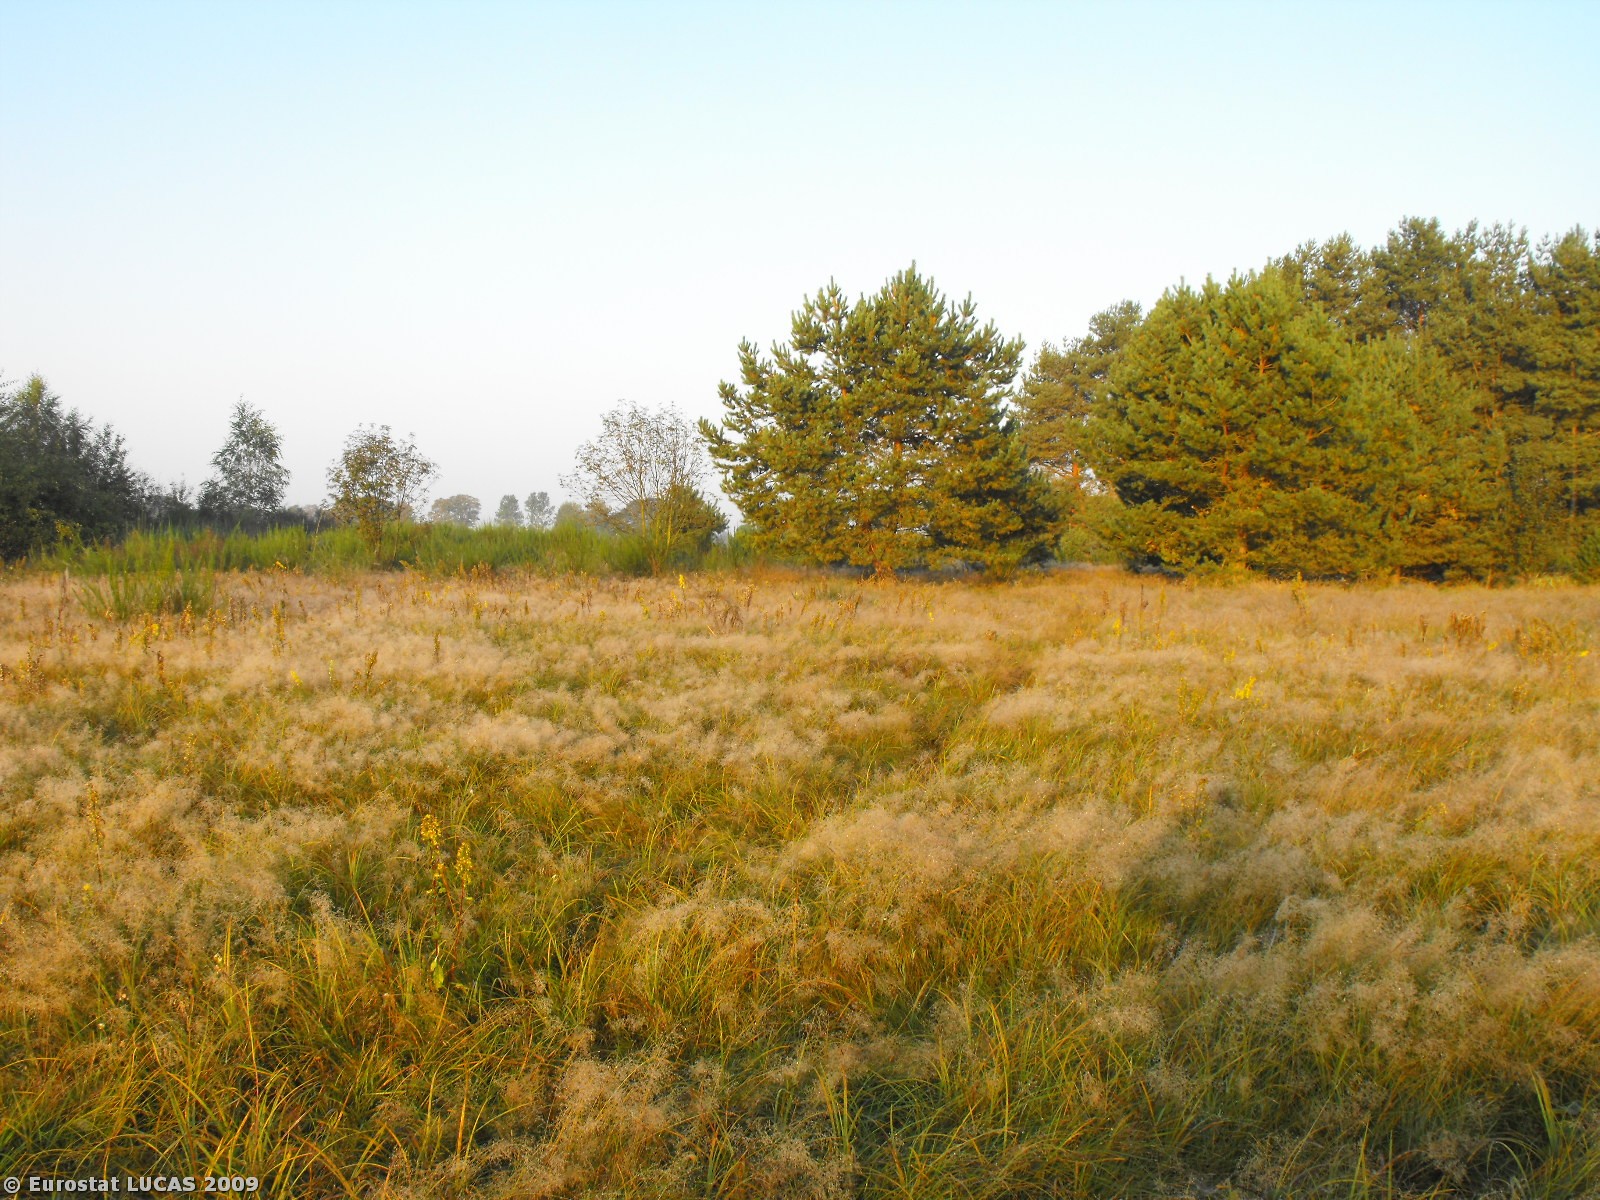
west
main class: Grassland
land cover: Grassland with sparse tree/shrub cover
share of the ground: > 75 %
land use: Nature reserves
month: September
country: PL
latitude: 54.4227
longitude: 16.7420
